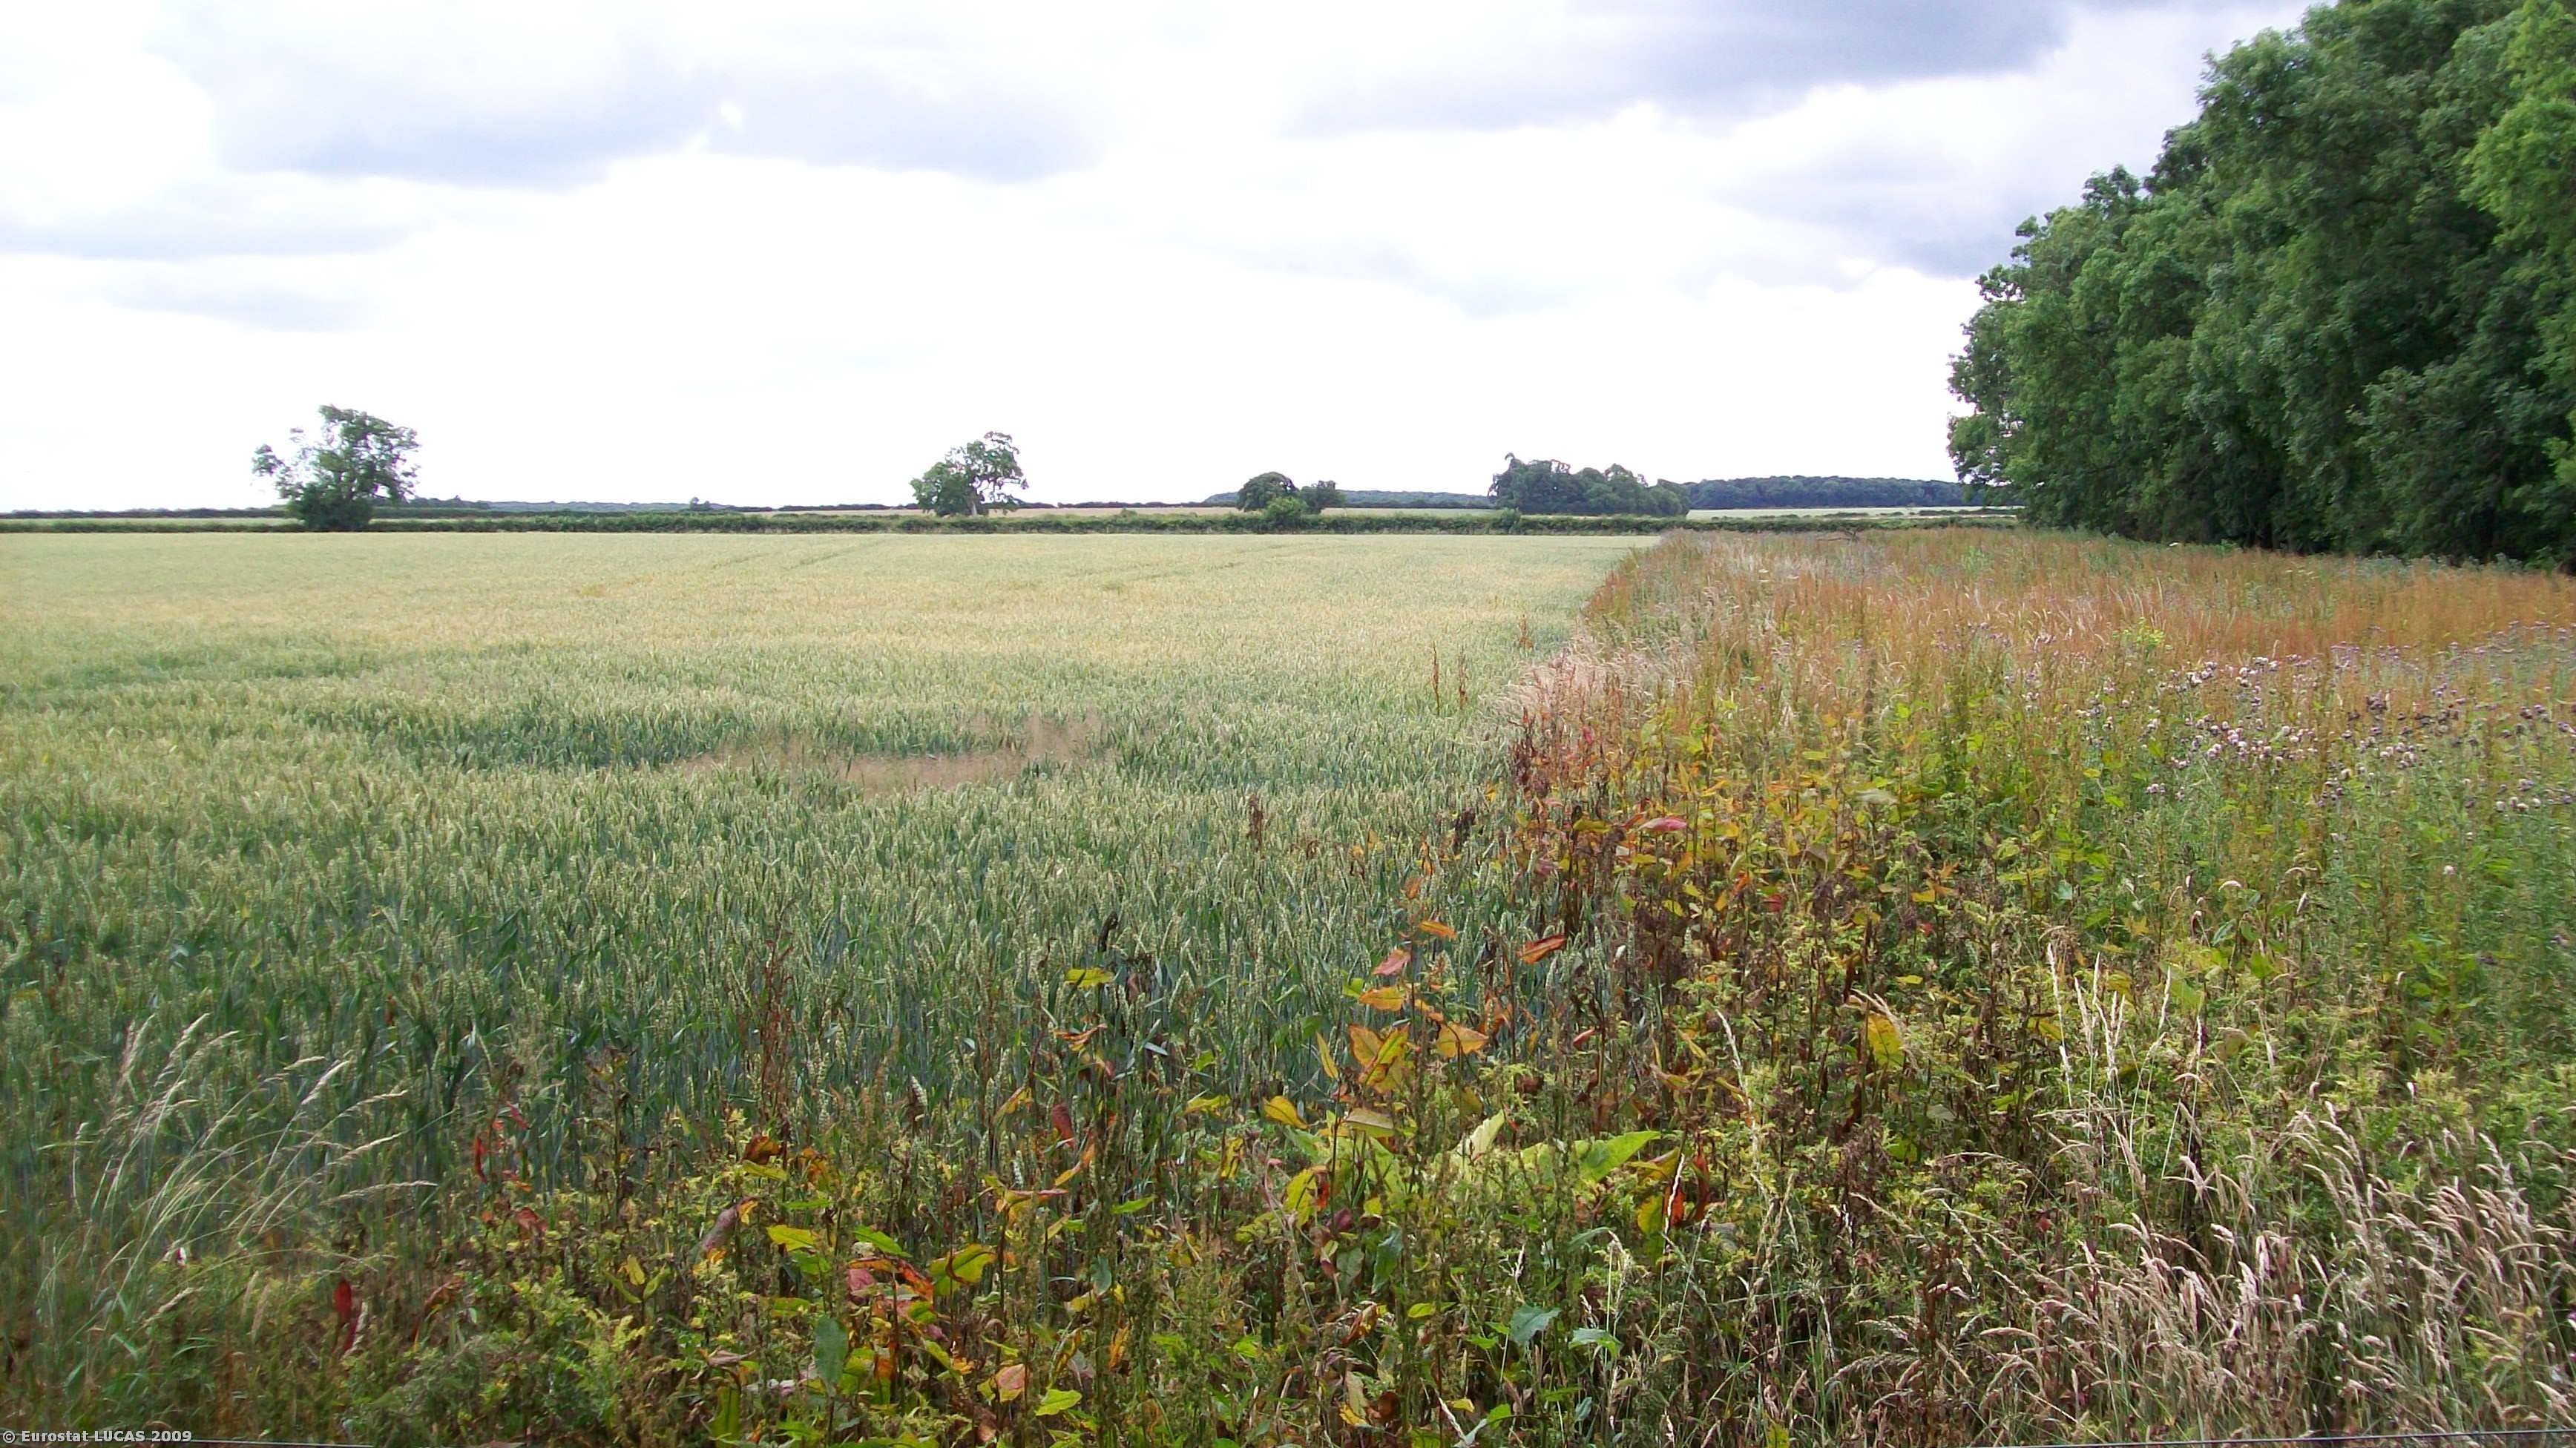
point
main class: Cropland
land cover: Common wheat
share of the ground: > 75 %
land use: Agriculture (excluding fallow land and kitchen gardens)
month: July
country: GB
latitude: 53.5458
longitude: -0.2515
